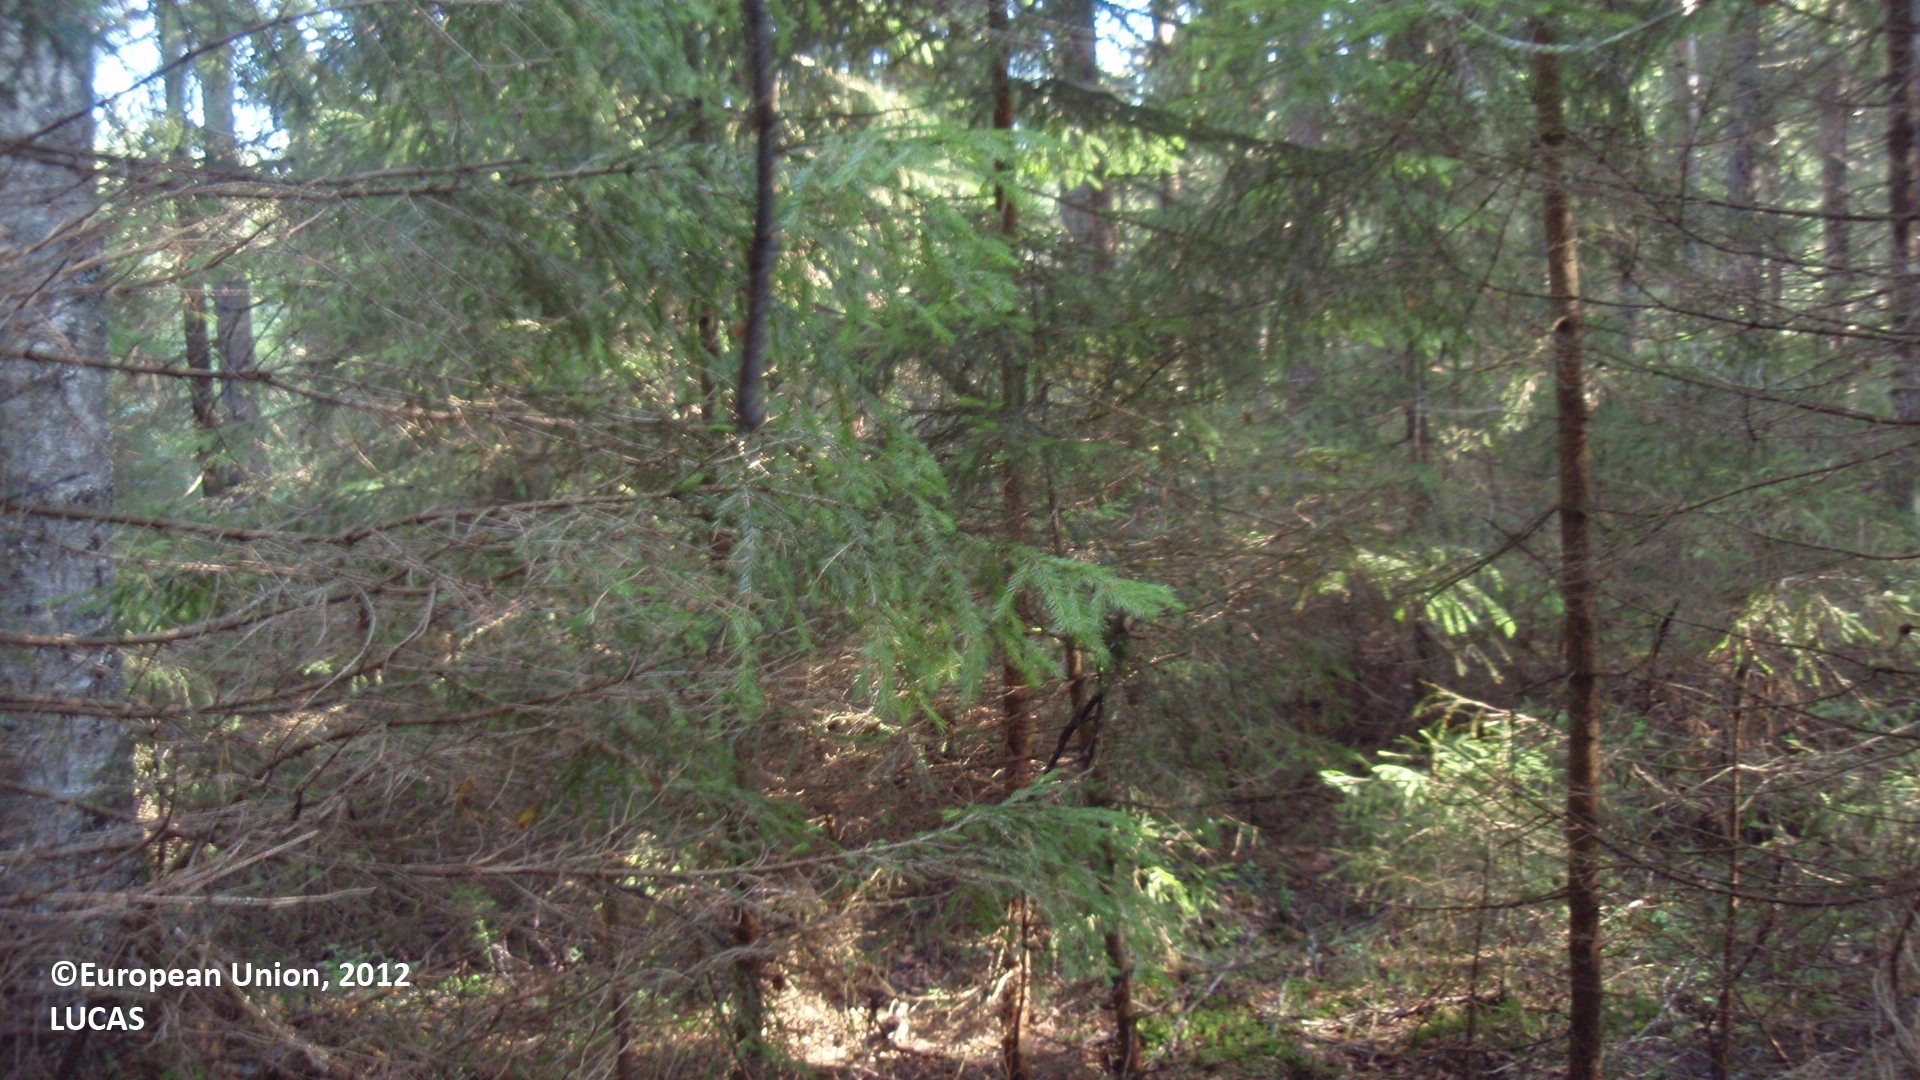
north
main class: Woodland
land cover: Spruce dominated mixed woodland
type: boreal forest
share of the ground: 50 - 75 %
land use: Forestry
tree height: > 5 m
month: August
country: FI
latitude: 60.6509
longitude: 27.3177
